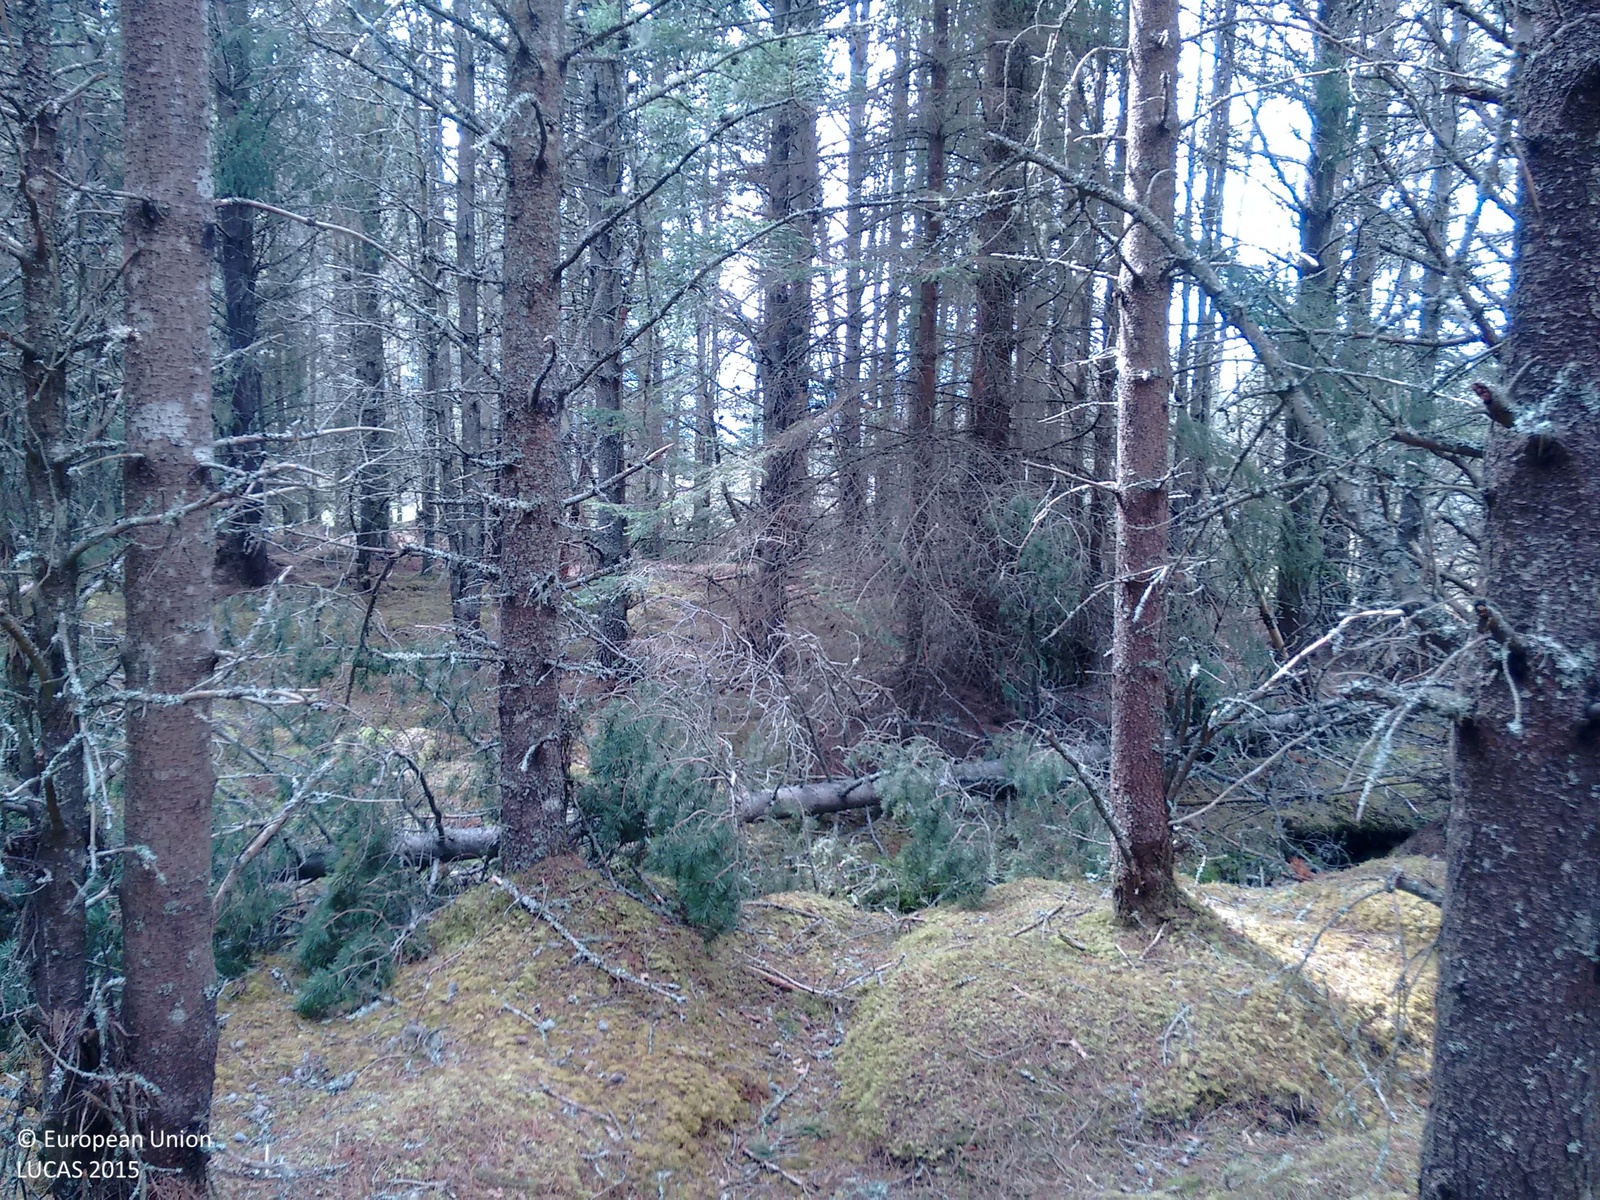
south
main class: Woodland
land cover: Spruce dominated coniferous woodland
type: exotic forest
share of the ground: > 75 %
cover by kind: coniferous forest trees 85 %, lichens and mosses 15 %
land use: Forestry
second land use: Amenities, museums, leisure
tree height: > 5 m
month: June
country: GB
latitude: 57.1816
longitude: -3.7247
